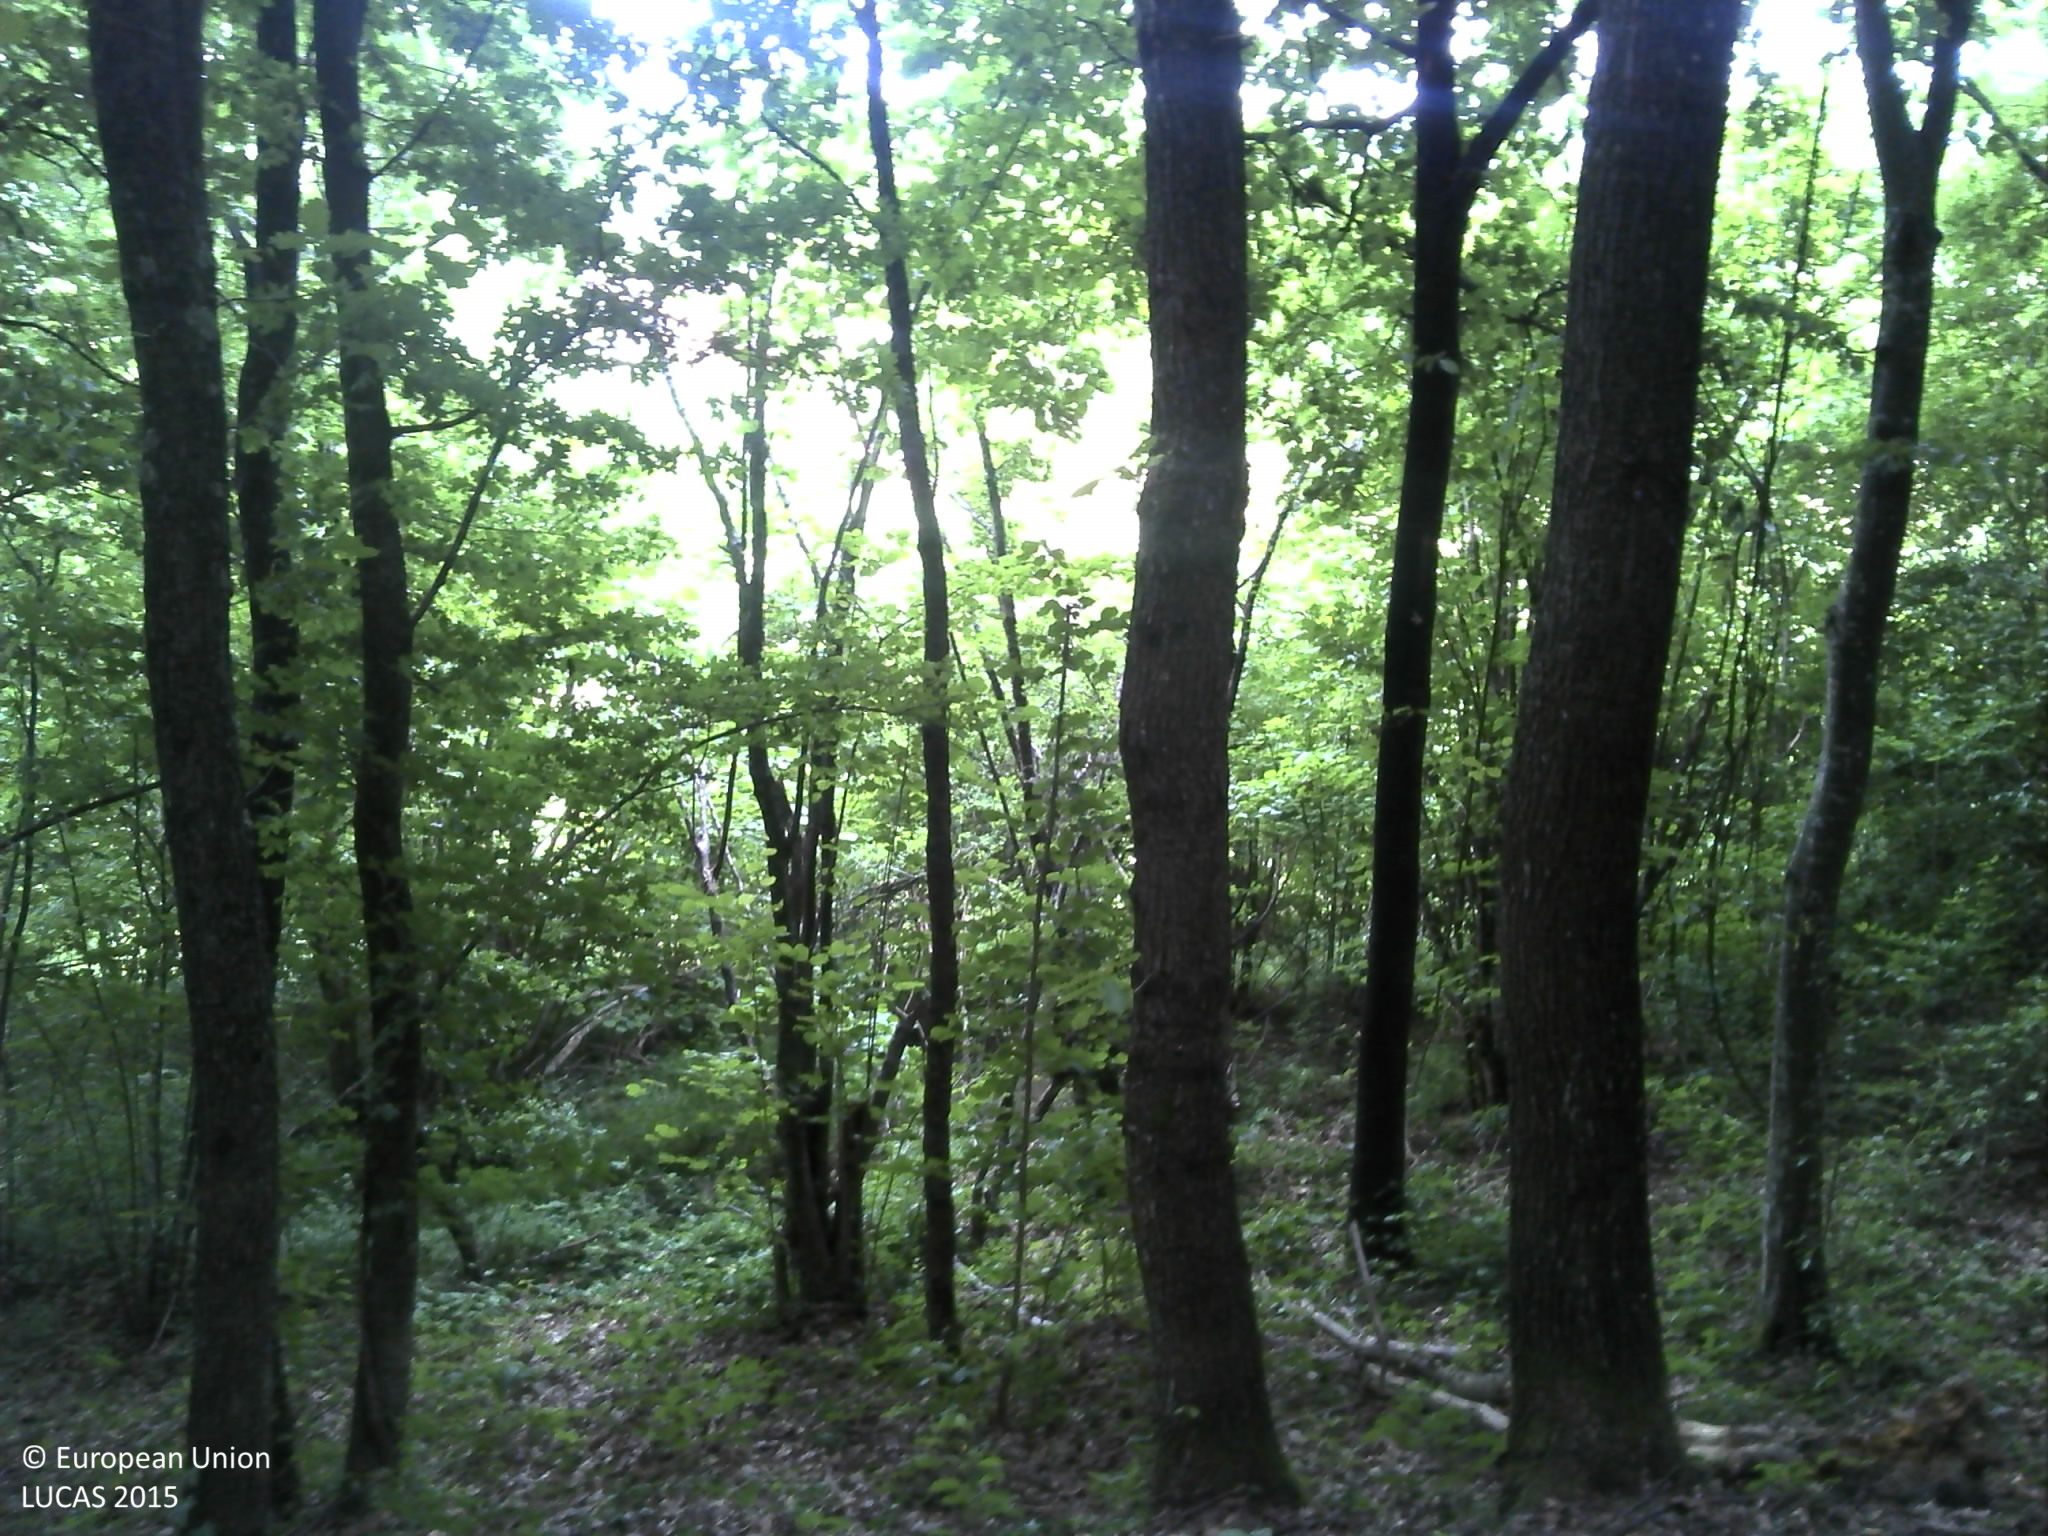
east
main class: Woodland
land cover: Broadleaved woodland
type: beech forest
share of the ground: > 75 %
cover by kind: broadleaved forest trees 80 %, lichens and mosses 20 %
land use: Forestry
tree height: > 5 m
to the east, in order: Broadleaved woodland; Grassland with sparse tree/shrub cover; Maize; Other fruit trees and berries; Artificial constructions in urban areas
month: June
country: HR
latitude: 45.4003
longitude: 17.5001
